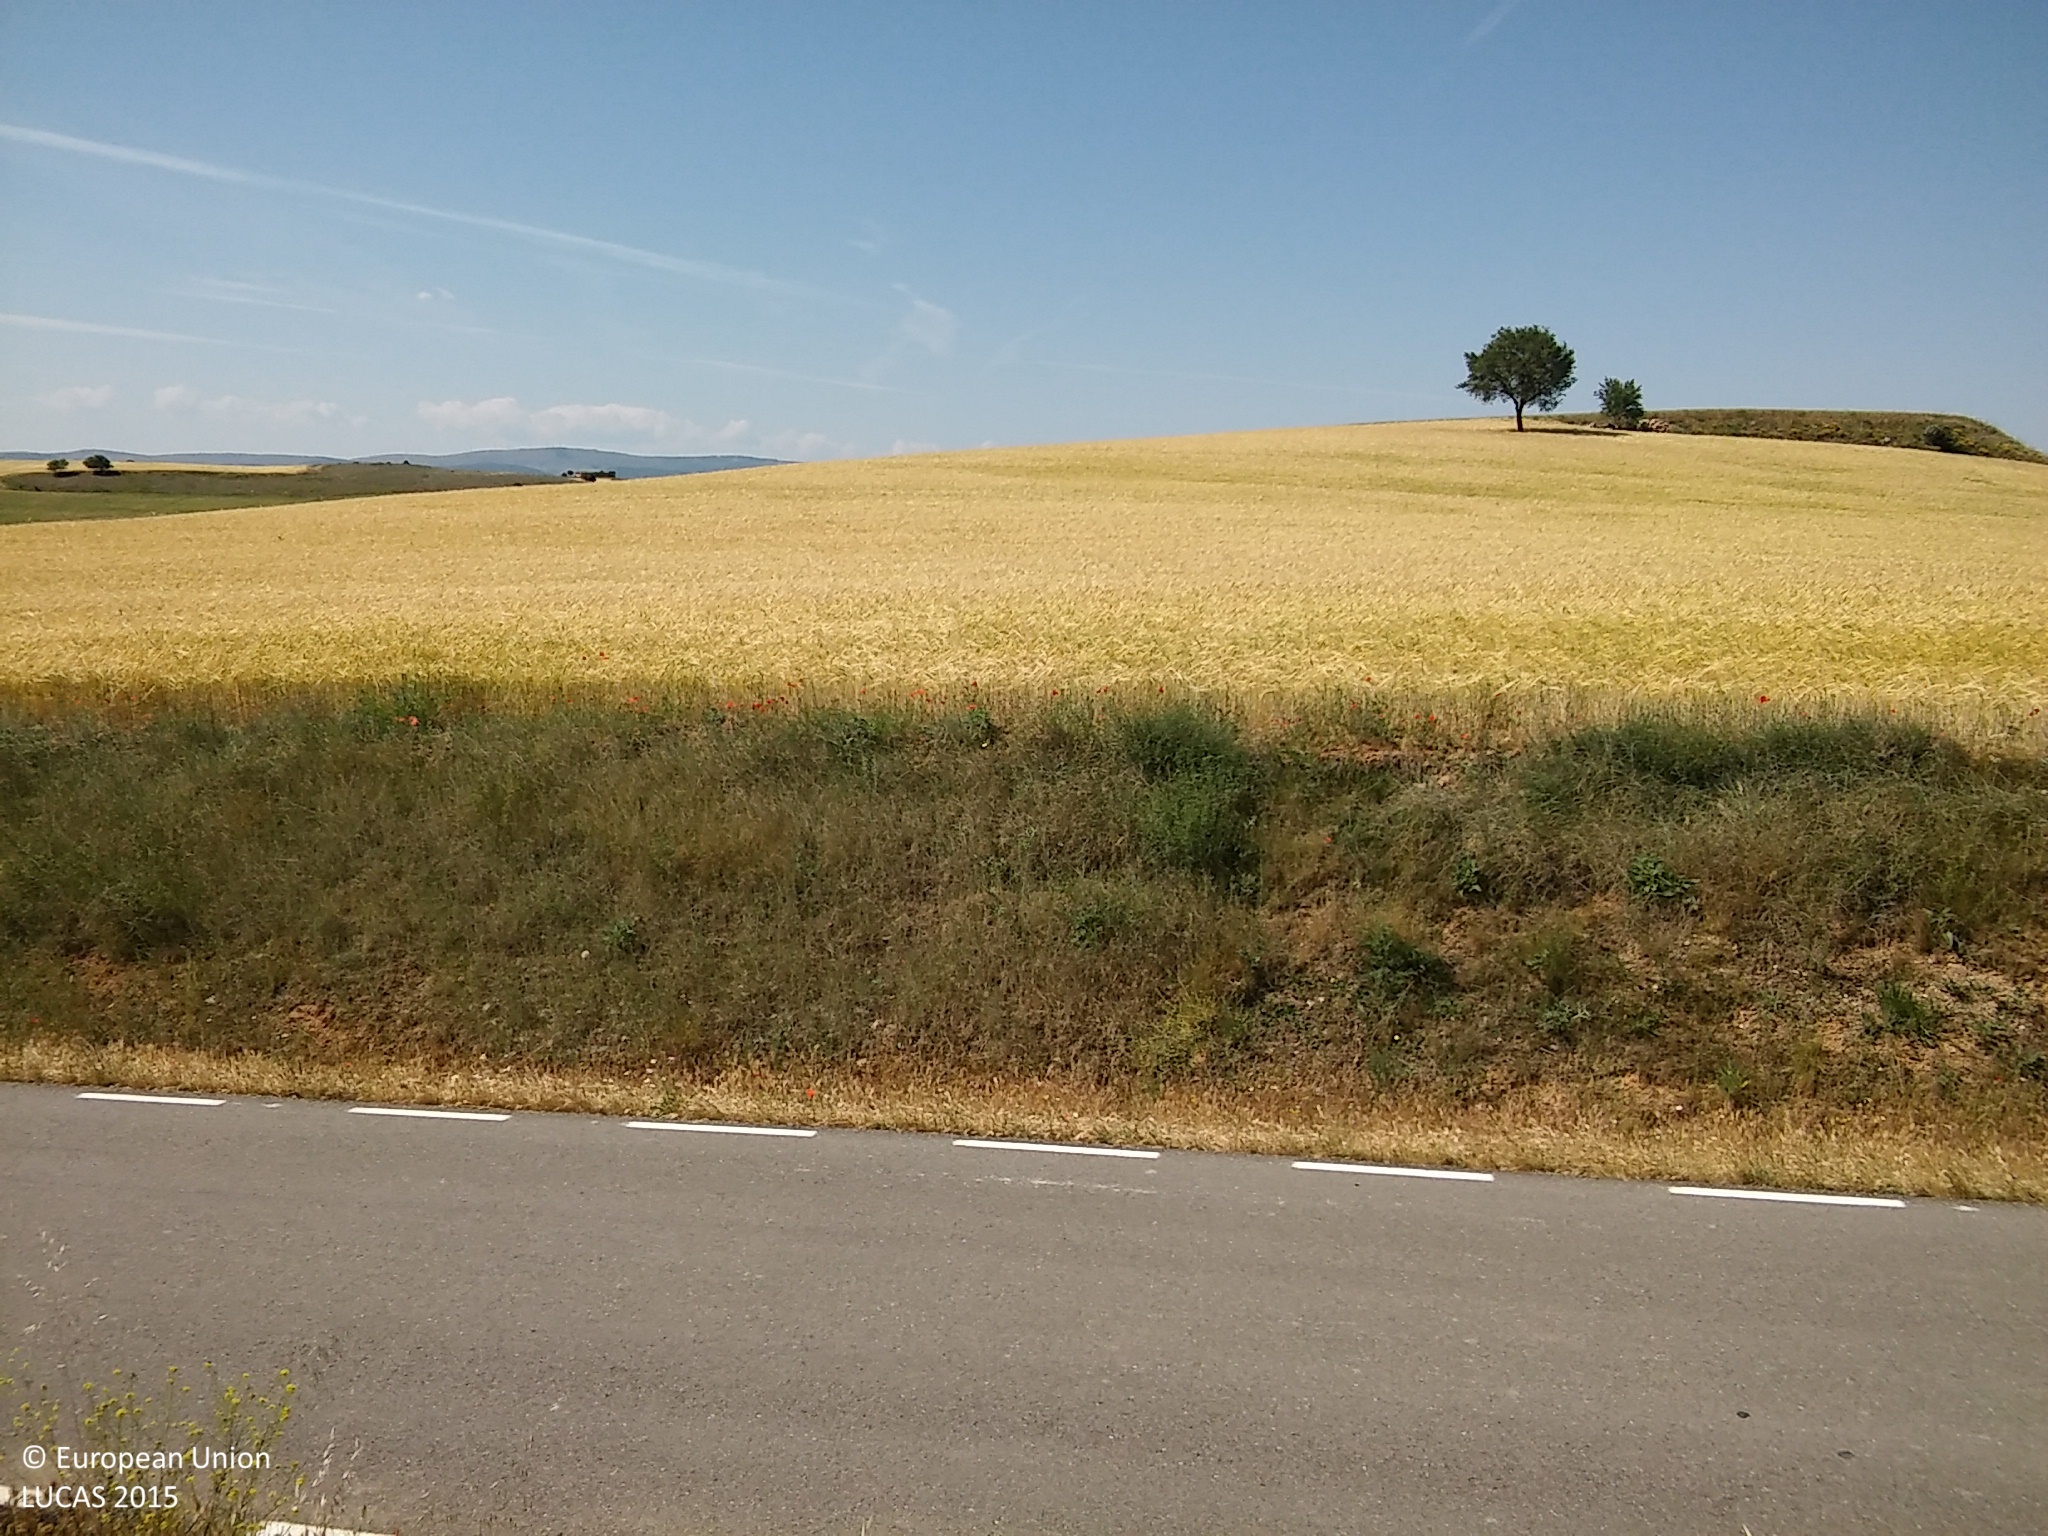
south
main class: Cropland
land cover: Common wheat
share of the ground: 50 - 75 %
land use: Agriculture (excluding fallow land and kitchen gardens)
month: June
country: ES
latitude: 41.6057
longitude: -3.7193
